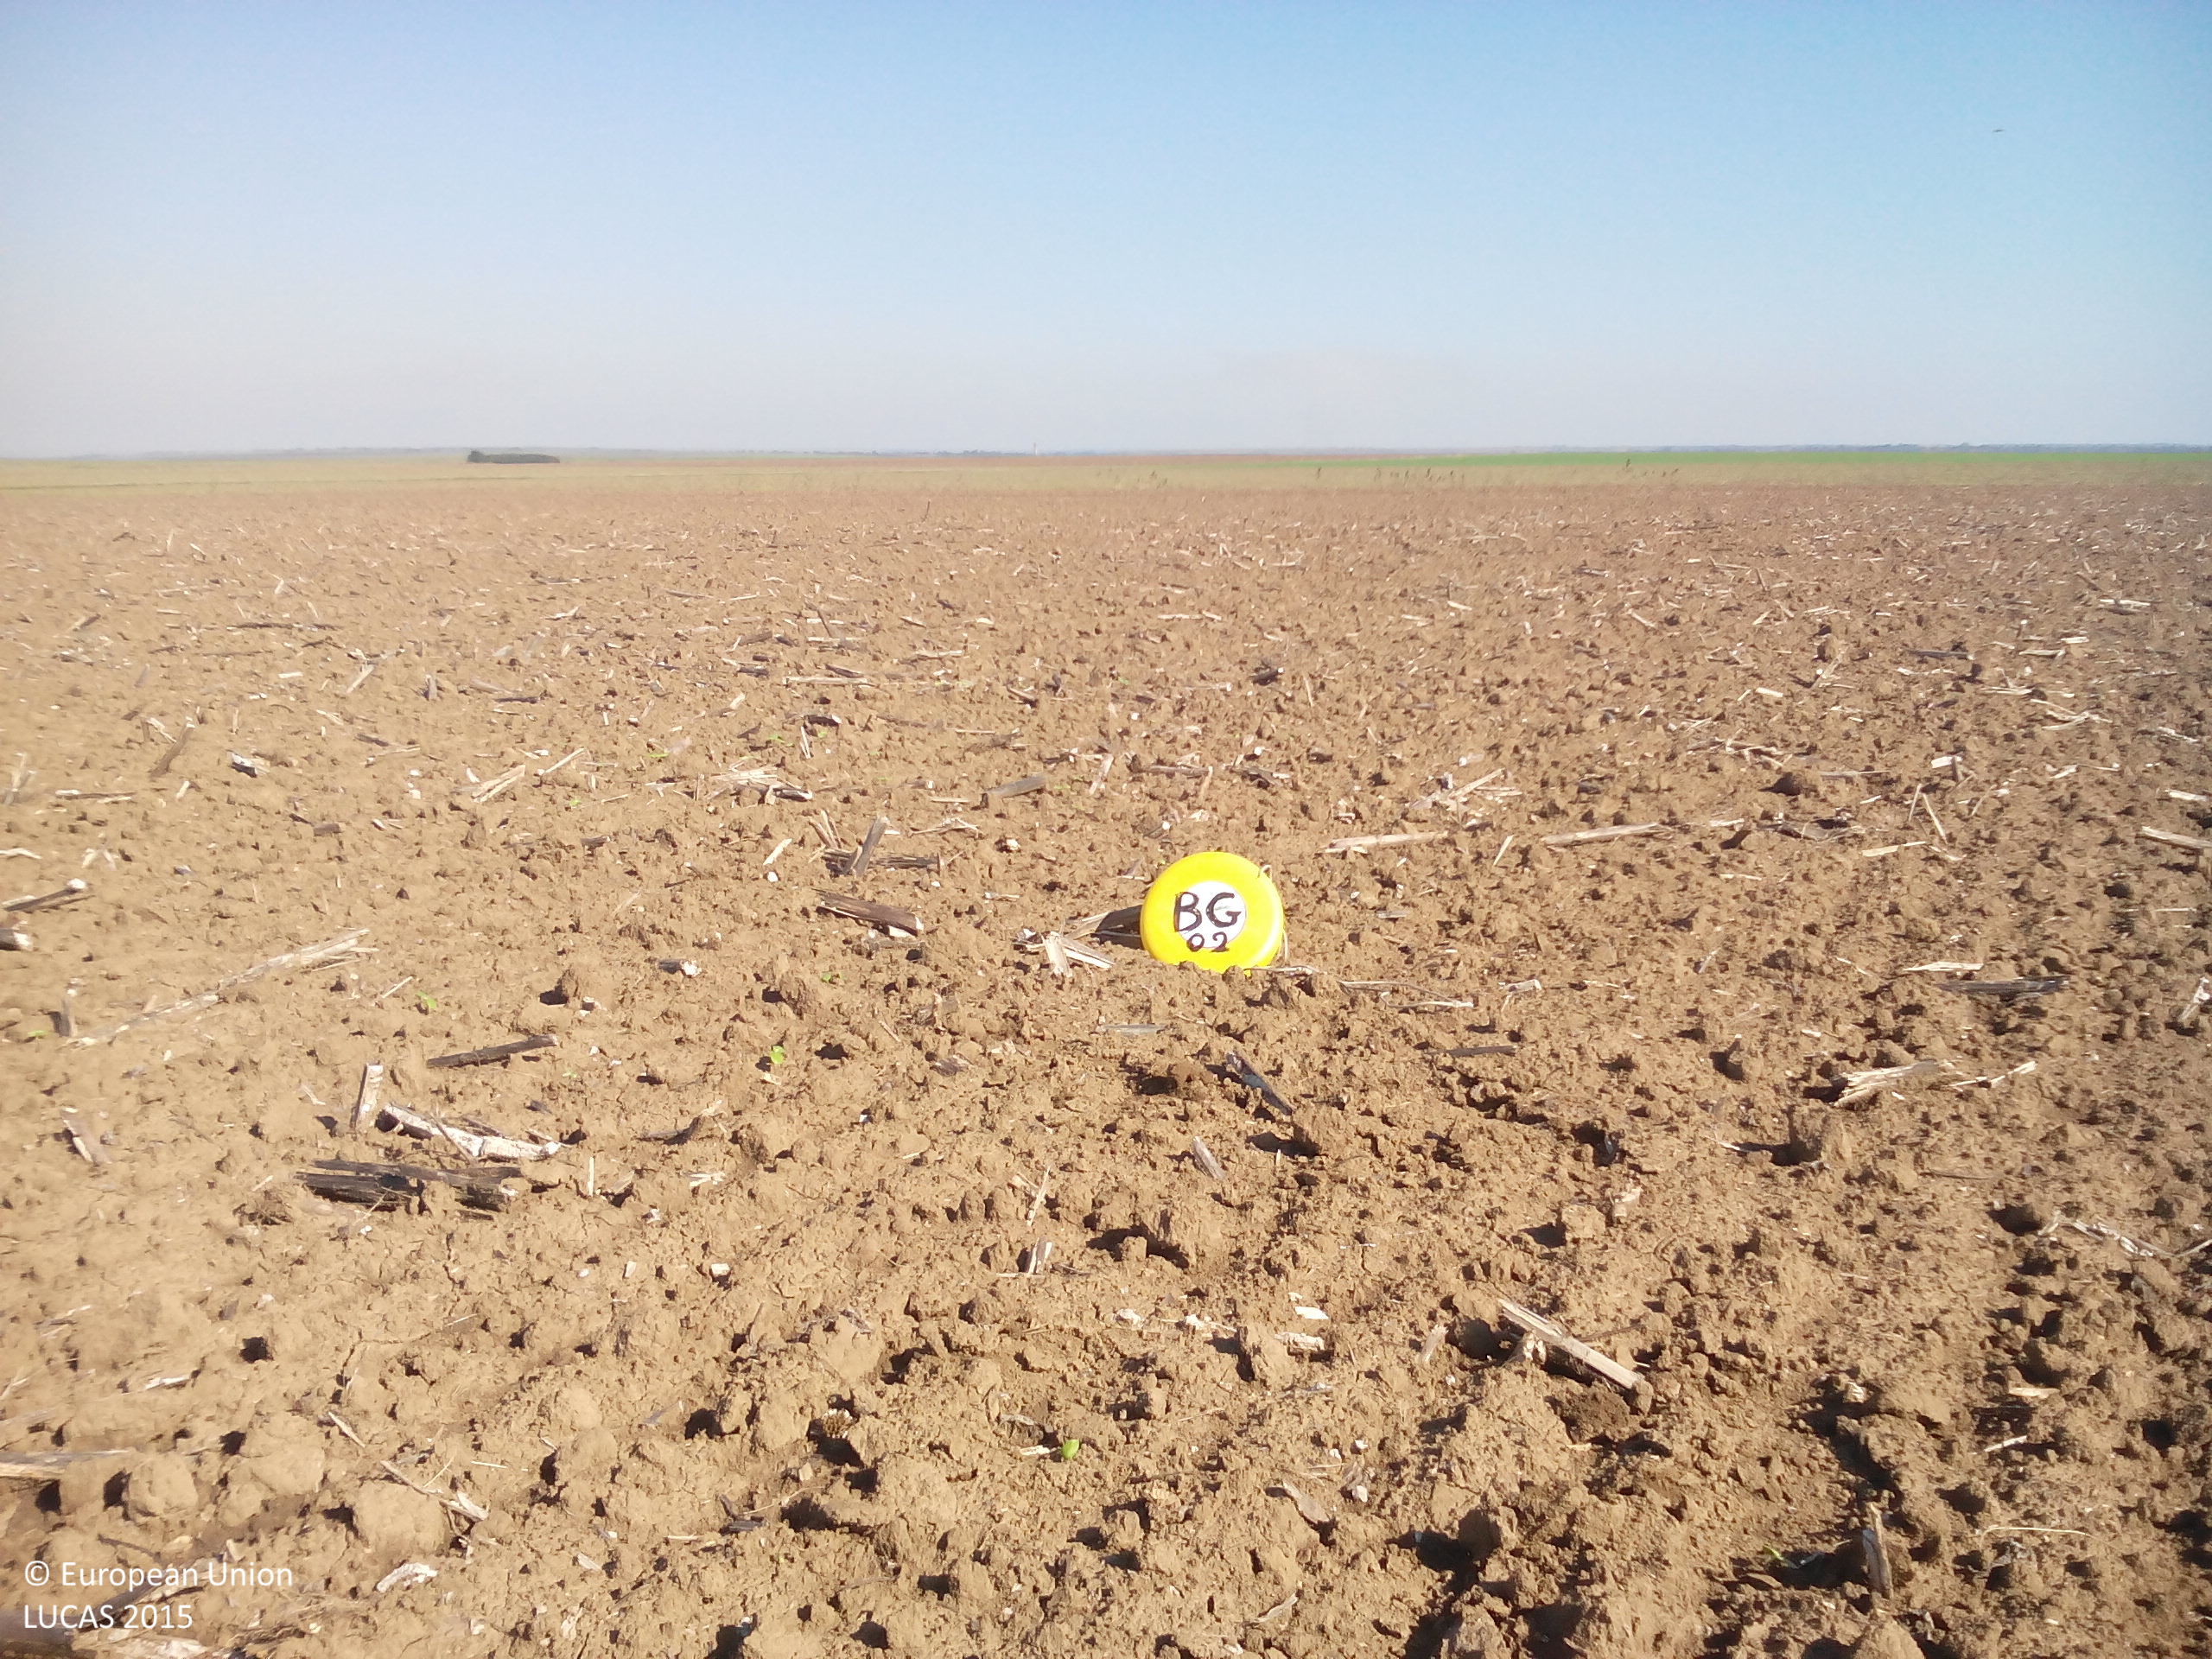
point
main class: Cropland
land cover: Sunflower
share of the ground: < 10 %
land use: Agriculture (excluding fallow land and kitchen gardens)
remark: Harvested field
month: October
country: BG
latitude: 43.5354
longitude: 23.6471
